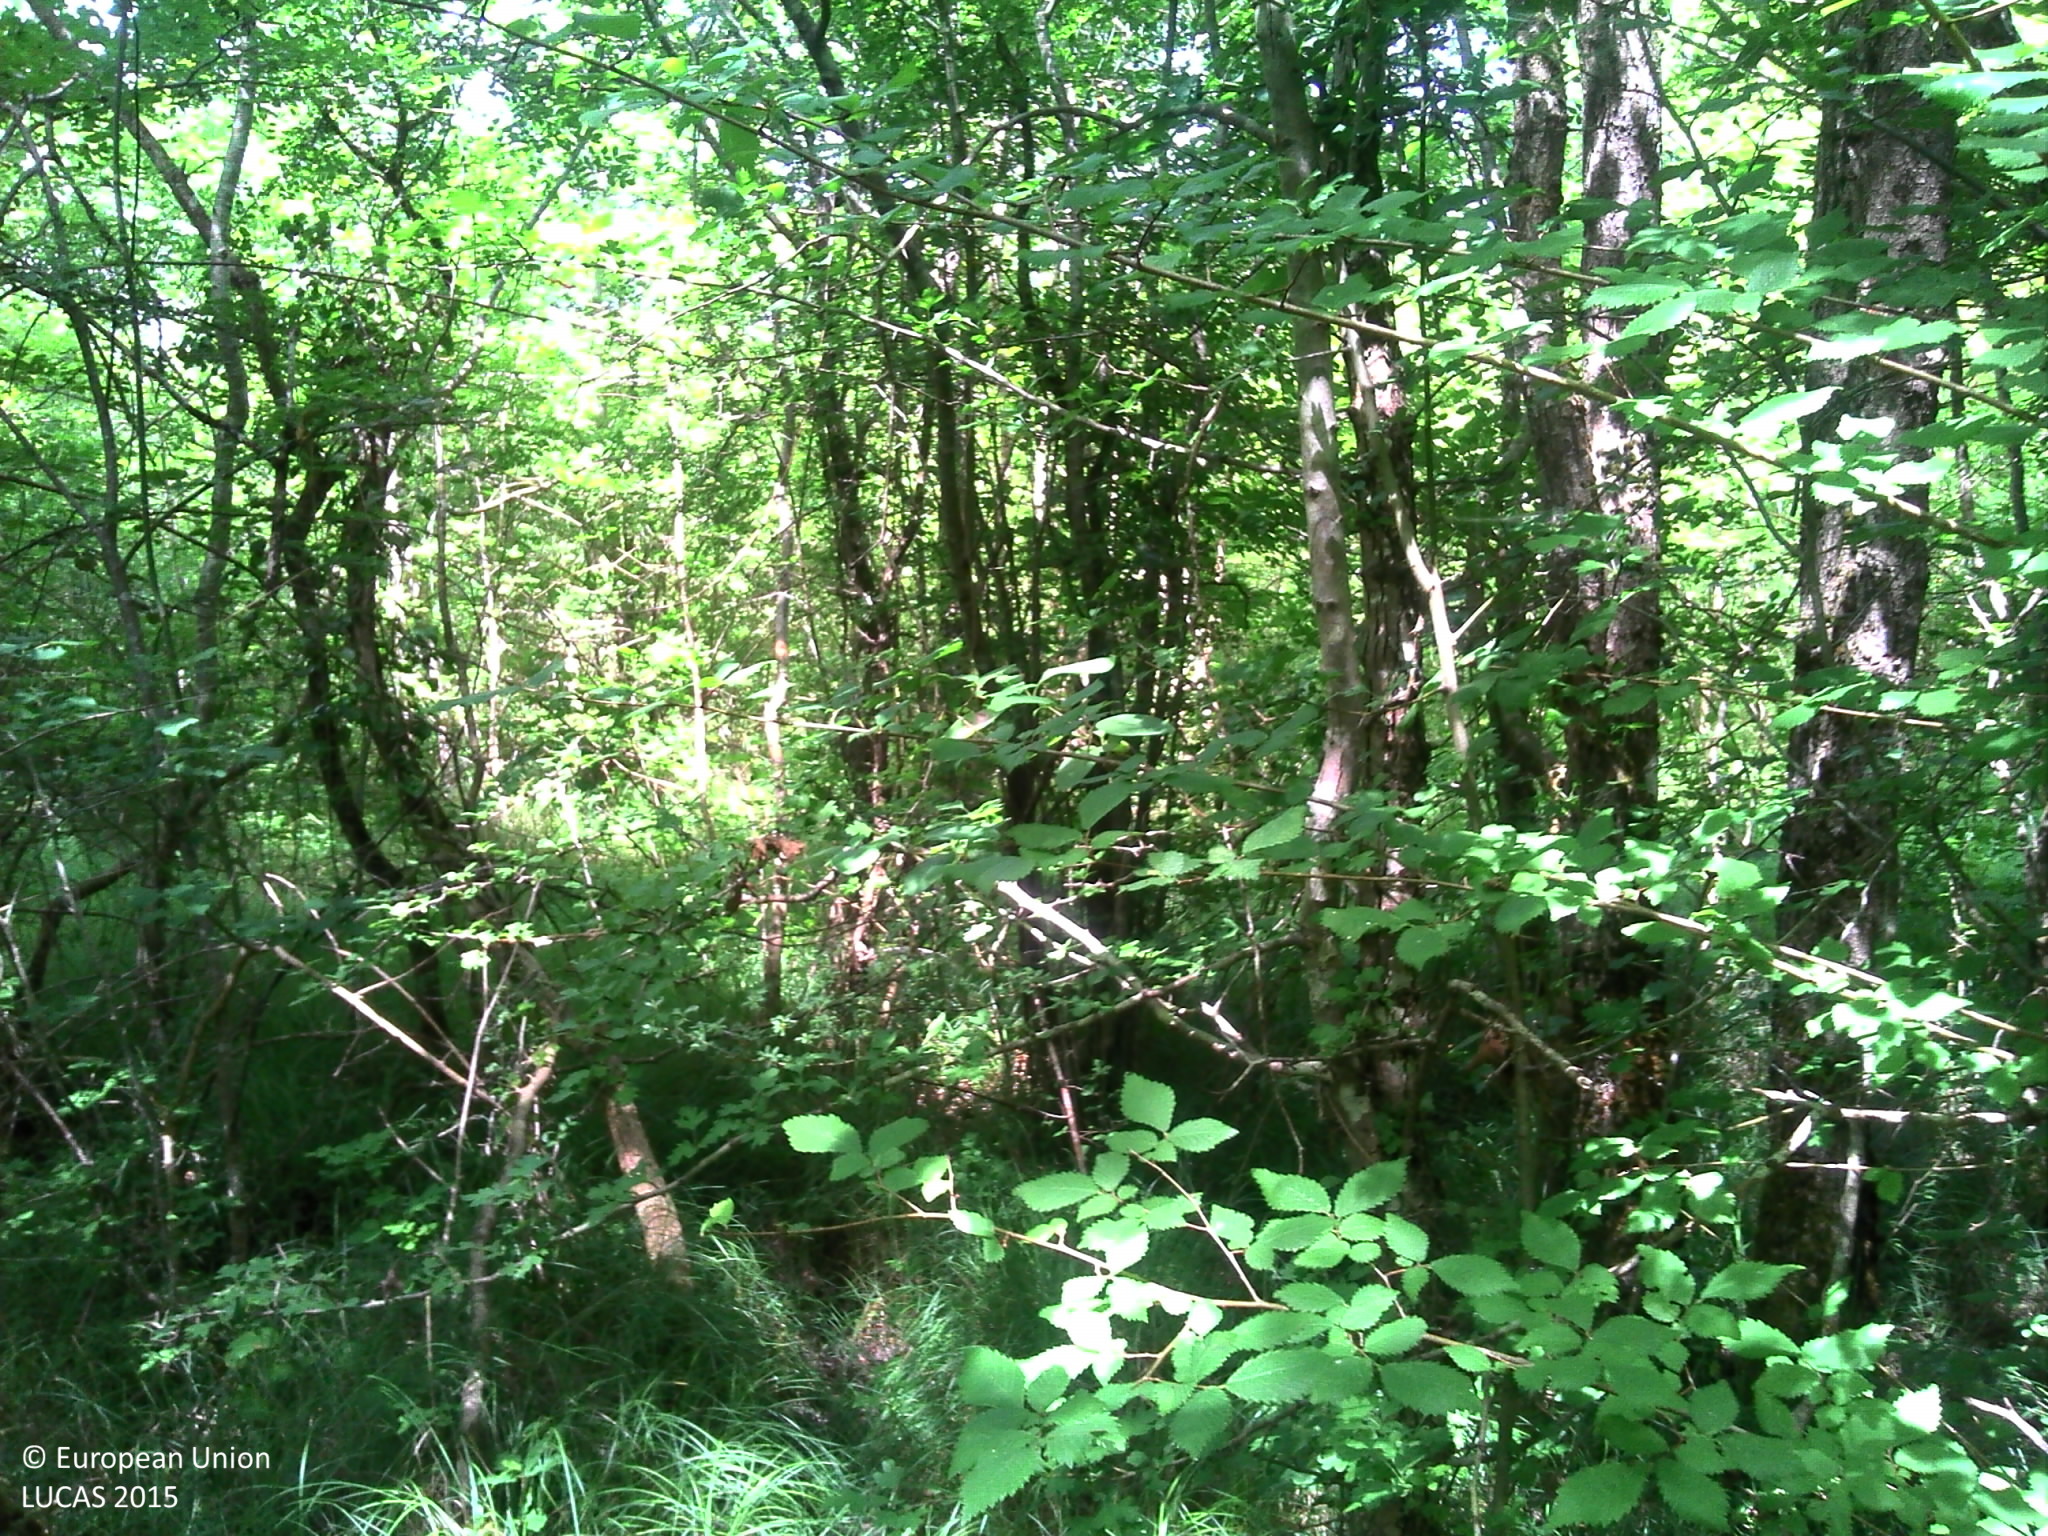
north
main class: Woodland
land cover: Broadleaved woodland
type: mesophytic deciduous forest
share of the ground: > 75 %
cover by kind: broadleaved forest trees 80 %, herbaceous plants 15 %, shrubs 5 %
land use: Forestry
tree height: > 5 m
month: June
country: FR
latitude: 45.7927
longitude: -0.8976
